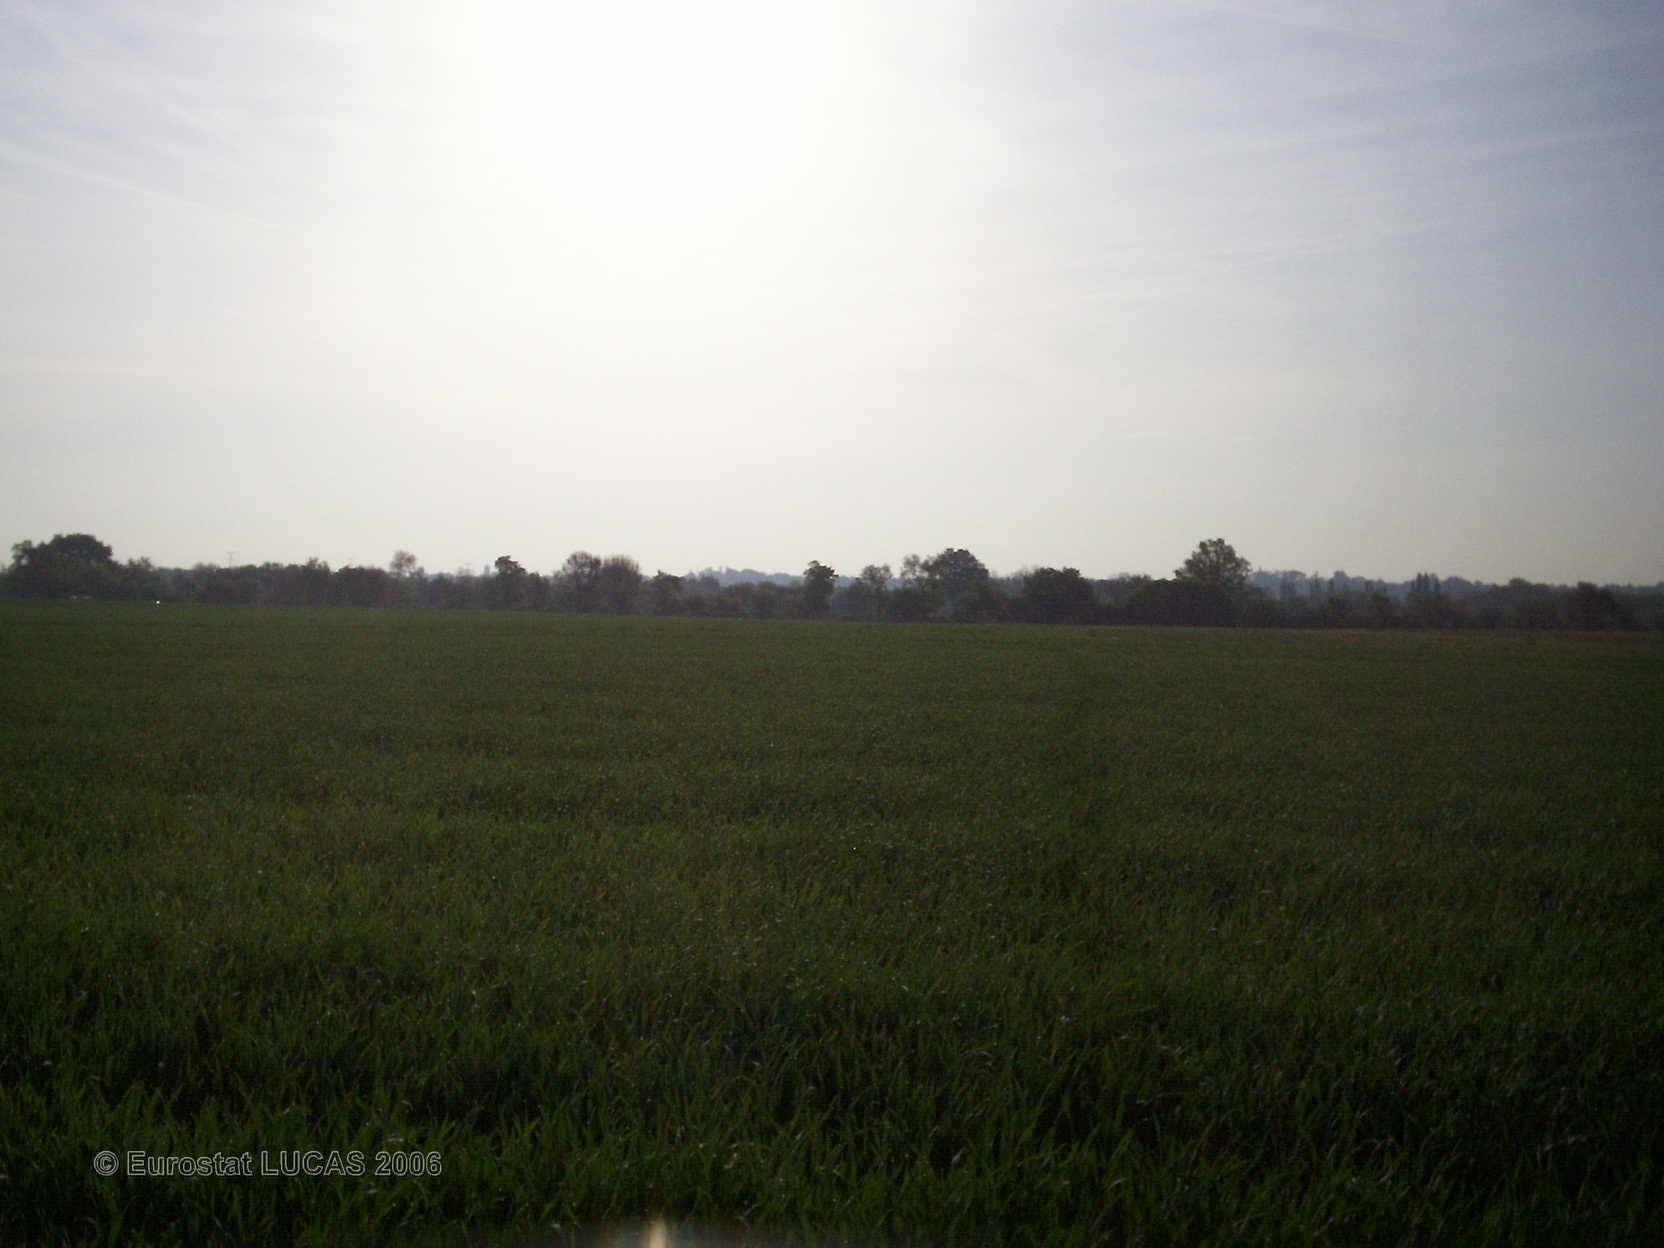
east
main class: Cropland
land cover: Common wheat
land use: Agriculture (excluding fallow land and kitchen gardens)
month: May
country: FR
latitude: 46.1518
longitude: 4.7846
